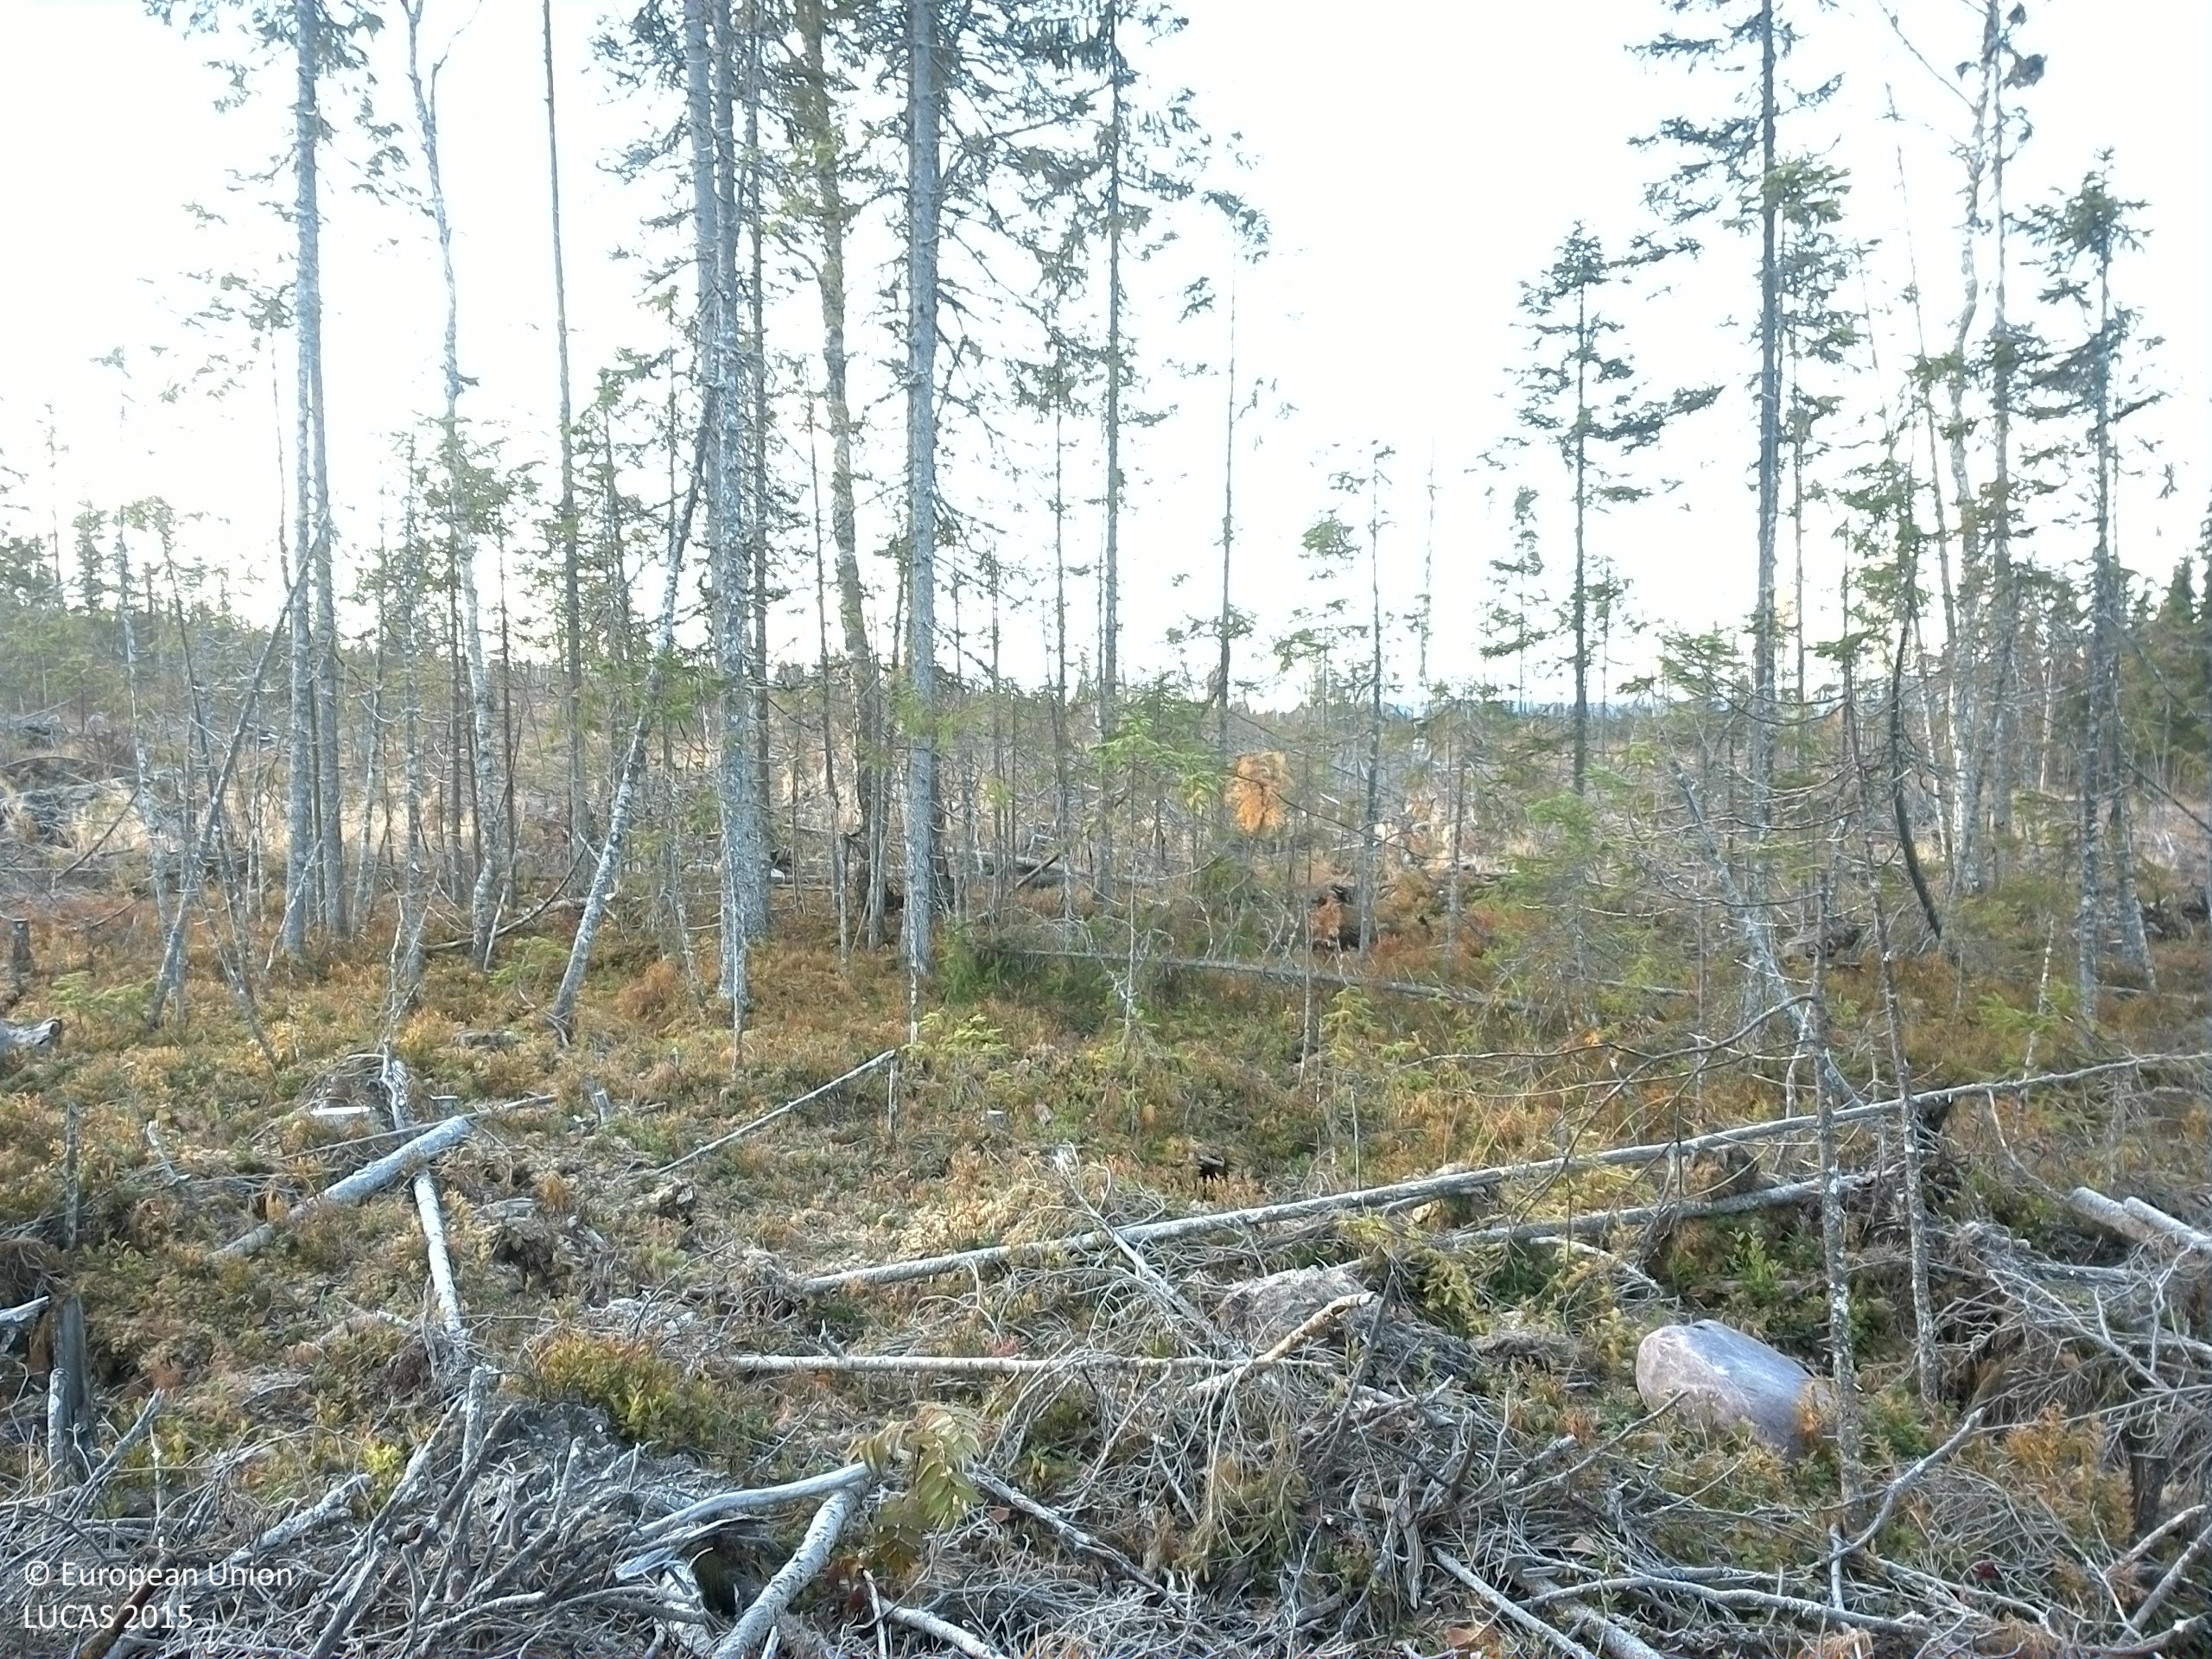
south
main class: Woodland
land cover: Spruce dominated coniferous woodland
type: boreal forest
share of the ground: 10 - 25 %
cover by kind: lichens and mosses 30 %, shrubs 25 %, unconsolidated bare surface 25 %, coniferous forest trees 10 %, herbaceous plants 10 %
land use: Forestry
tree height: < 5 m
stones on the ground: < 10 %
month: October
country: SE
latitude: 64.1806
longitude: 15.8770
